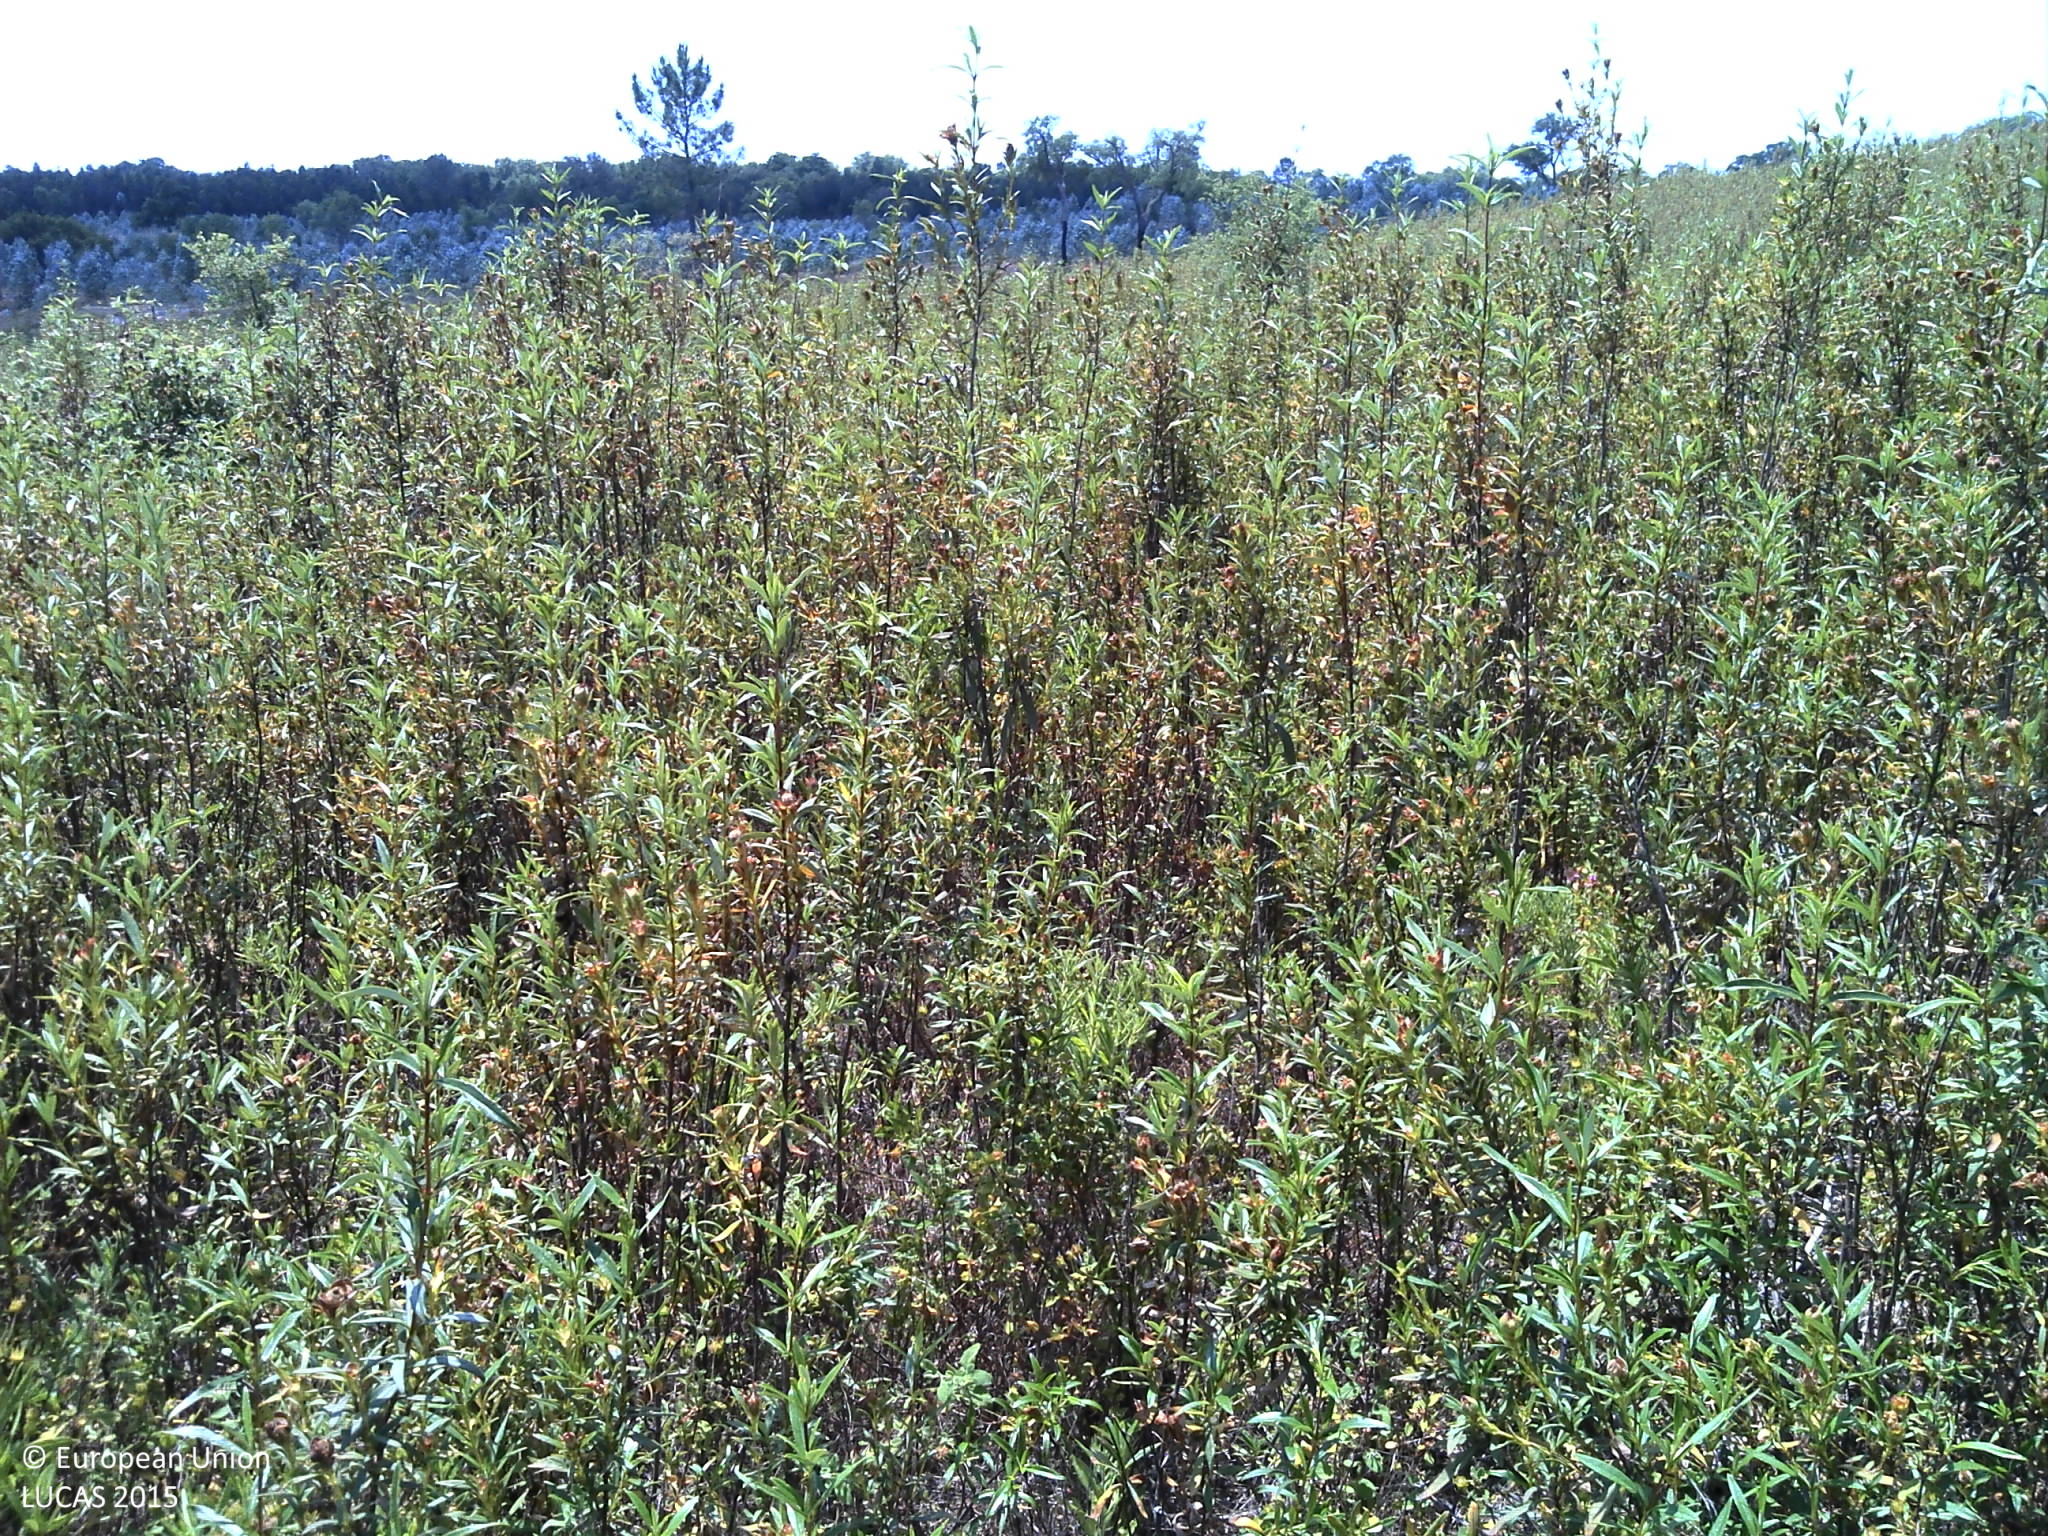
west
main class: Shrubland
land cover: Shrubland with sparse tree cover
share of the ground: > 75 %
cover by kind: shrubs 75 %, herbaceous plants 10 %, unconsolidated bare surface 10 %, broadleaved forest trees 5 %
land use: Semi-natural and natural areas not in use
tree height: < 5 m
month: May
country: PT
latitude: 37.8371
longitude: -8.5276
